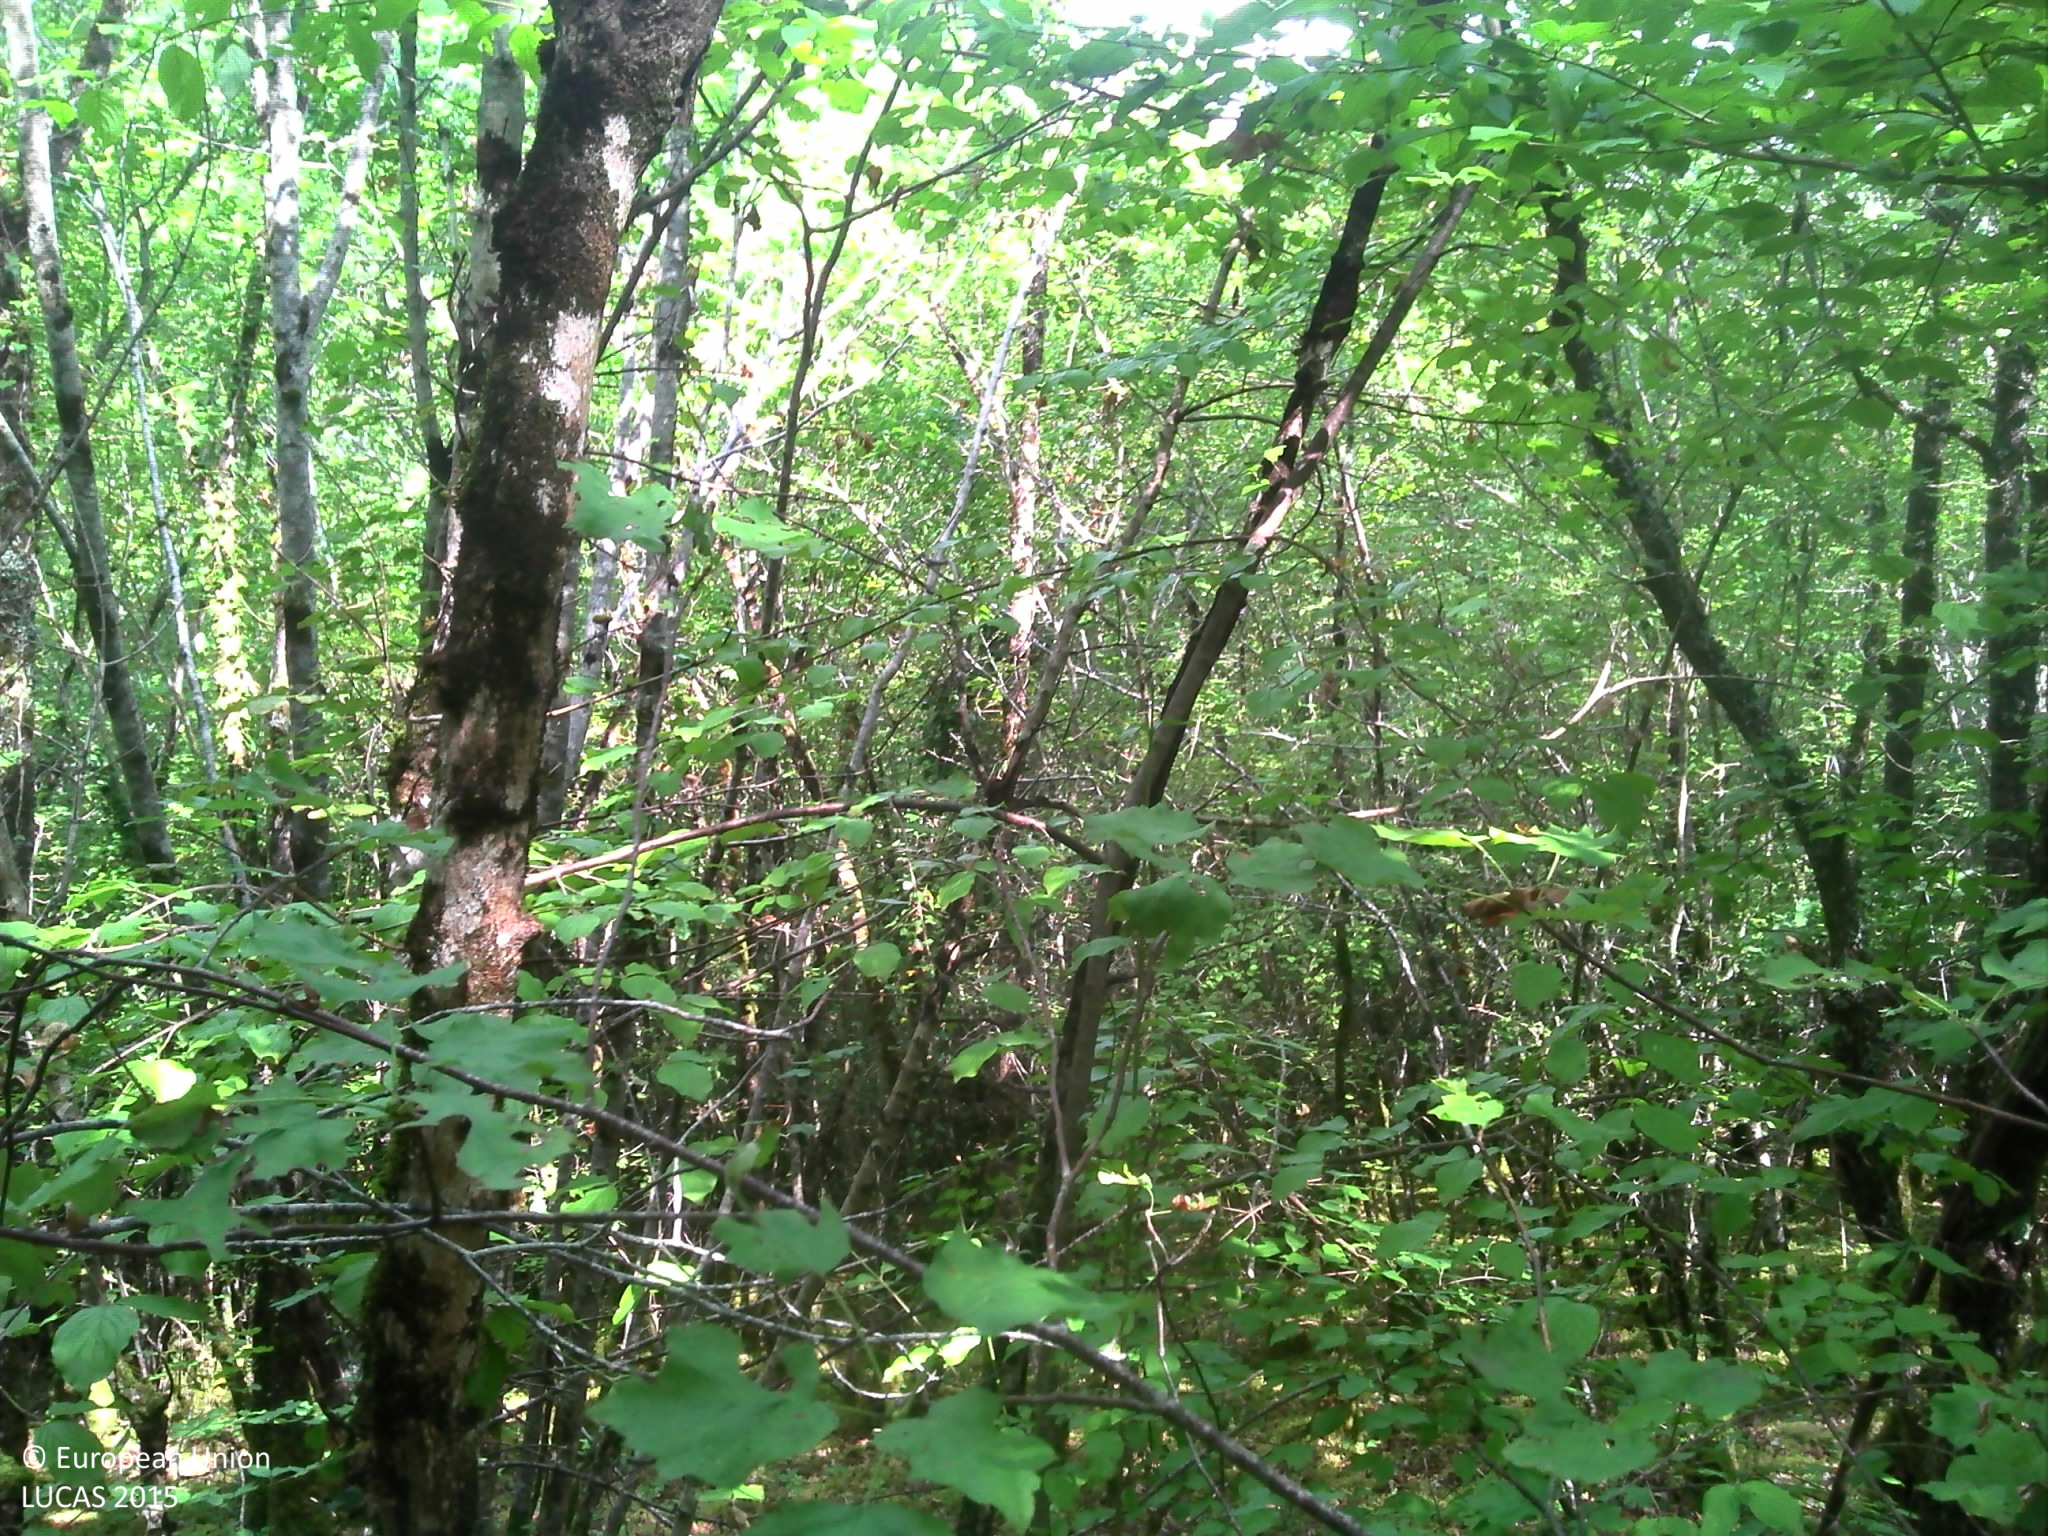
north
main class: Woodland
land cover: Broadleaved woodland
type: acidophilous oak and oak-birch forest
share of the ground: > 75 %
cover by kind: broadleaved forest trees 80 %, herbaceous plants 10 %, lichens and mosses 10 %
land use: Forestry
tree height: > 5 m
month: August
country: FR
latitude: 44.9211
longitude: 1.4447
